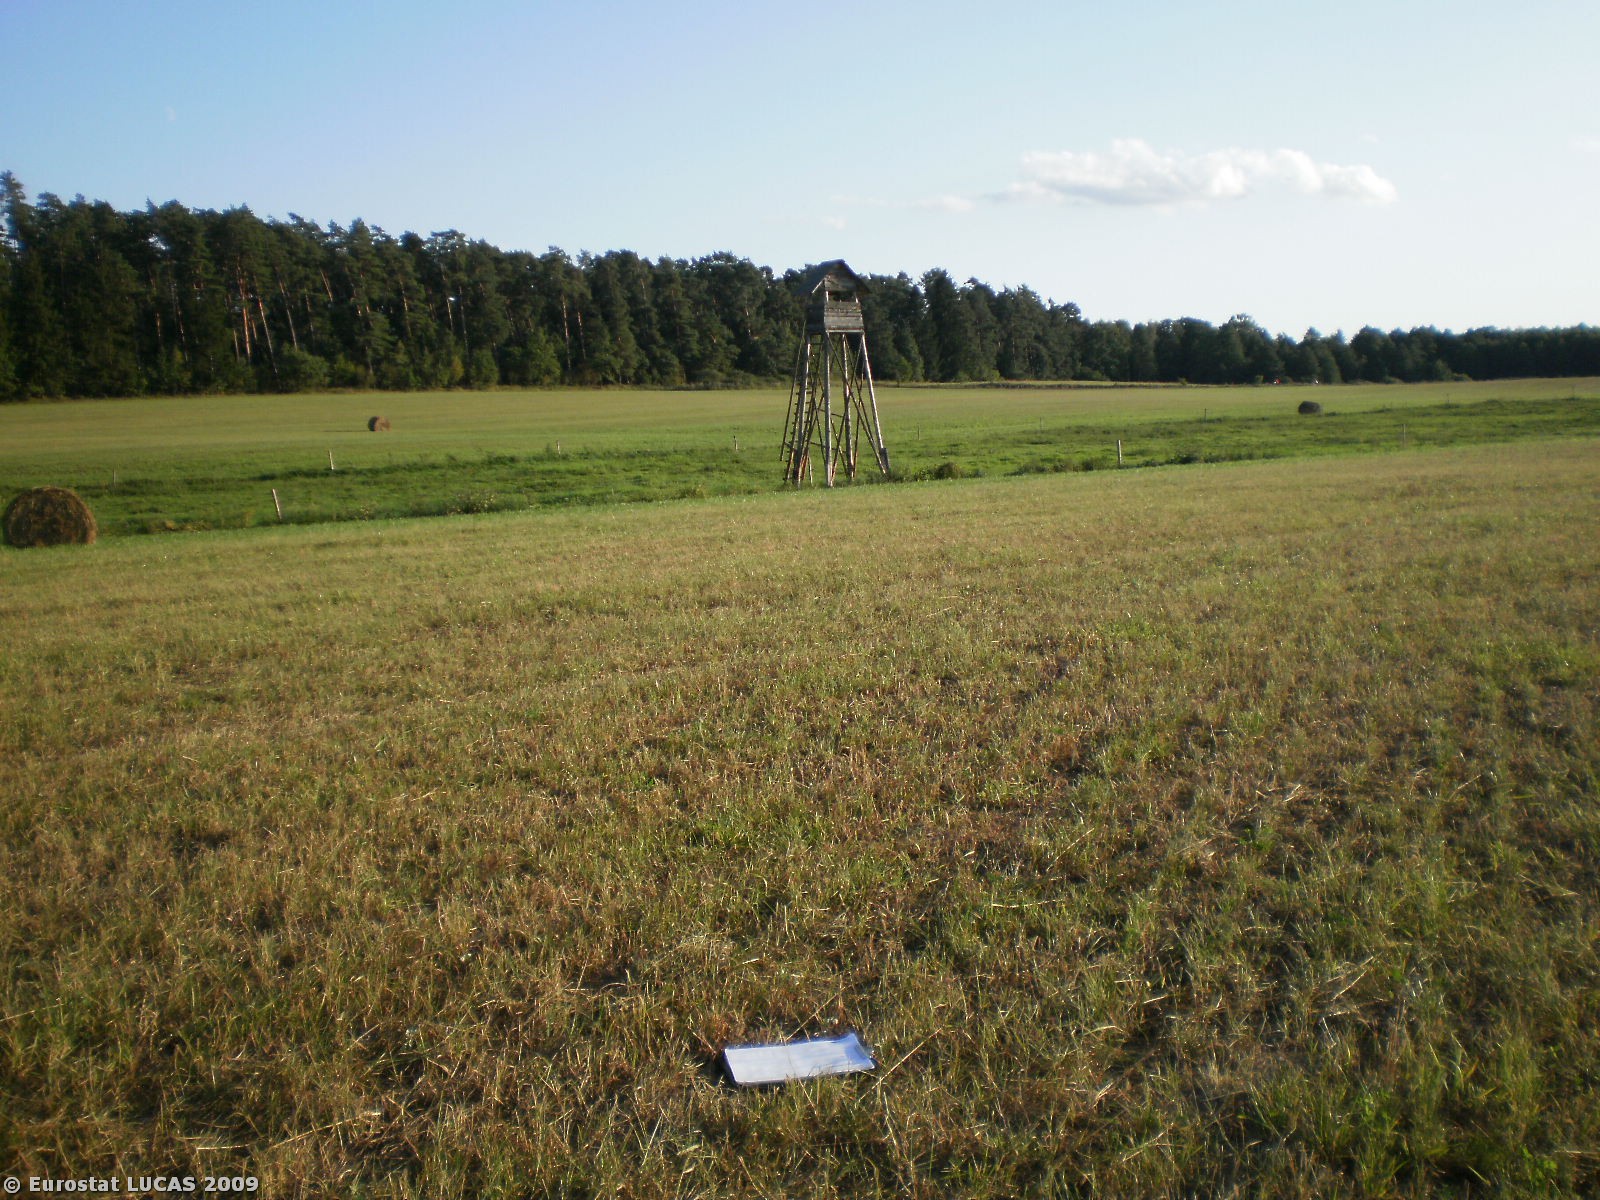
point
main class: Grassland
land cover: Grassland without tree/shrub cover
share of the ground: > 75 %
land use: Agriculture (excluding fallow land and kitchen gardens)
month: August
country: PL
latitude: 53.8344
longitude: 21.6766
